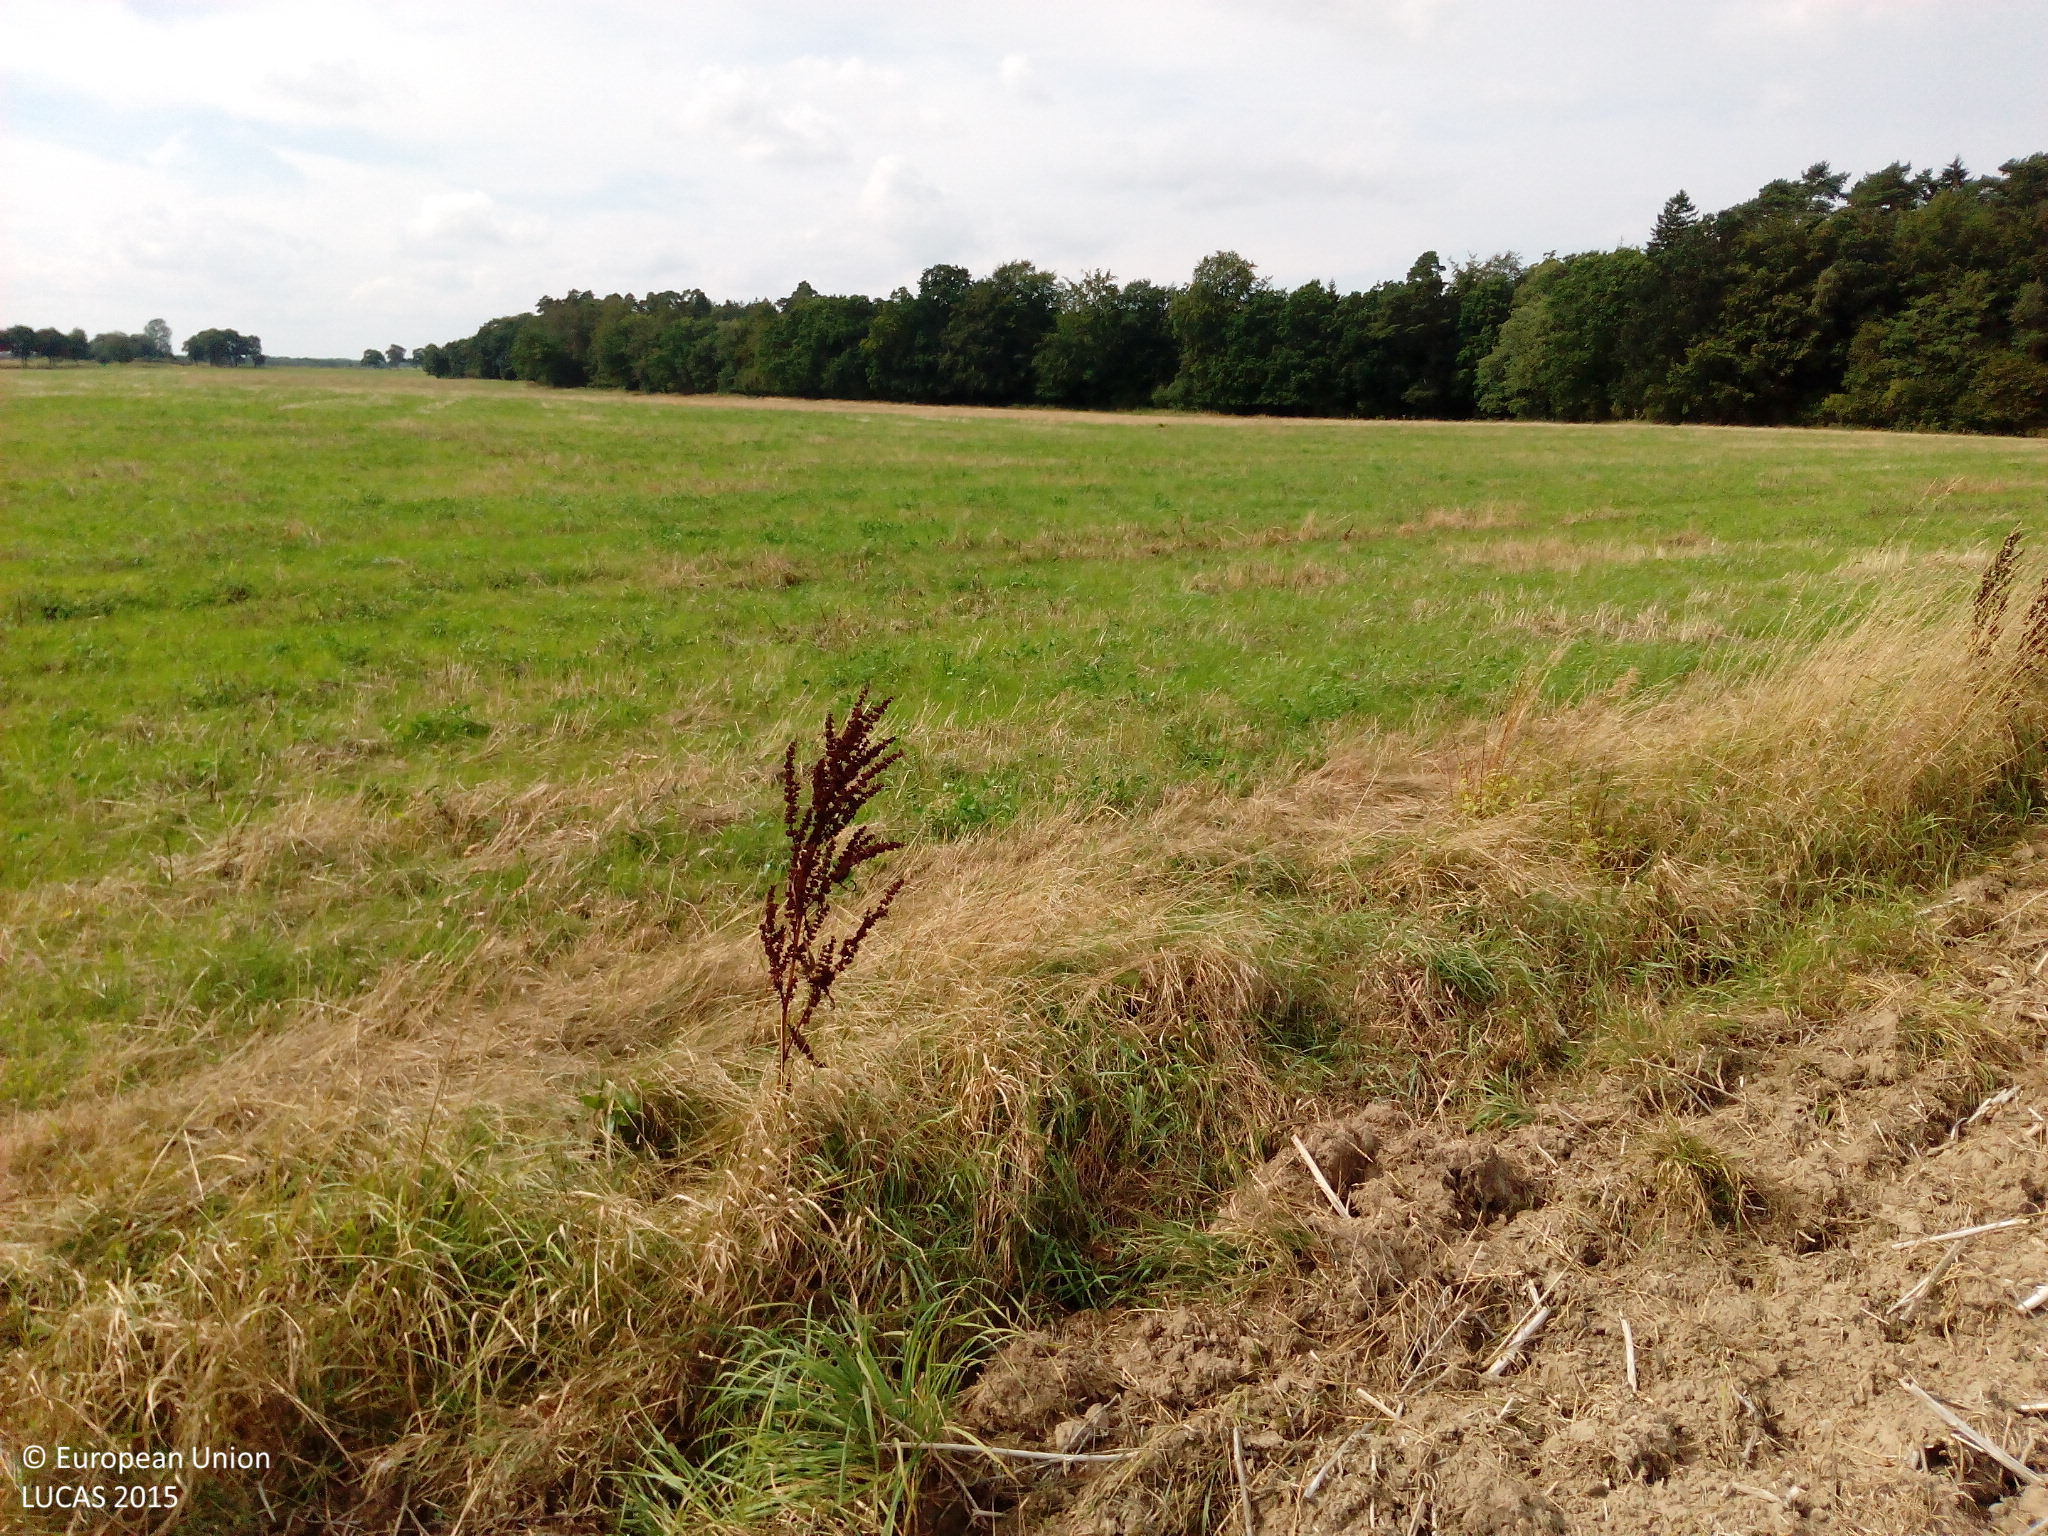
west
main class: Cropland
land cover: Rape and turnip rape
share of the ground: < 10 %
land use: Agriculture (excluding fallow land and kitchen gardens)
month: September
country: DE
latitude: 54.1501
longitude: 12.4641
